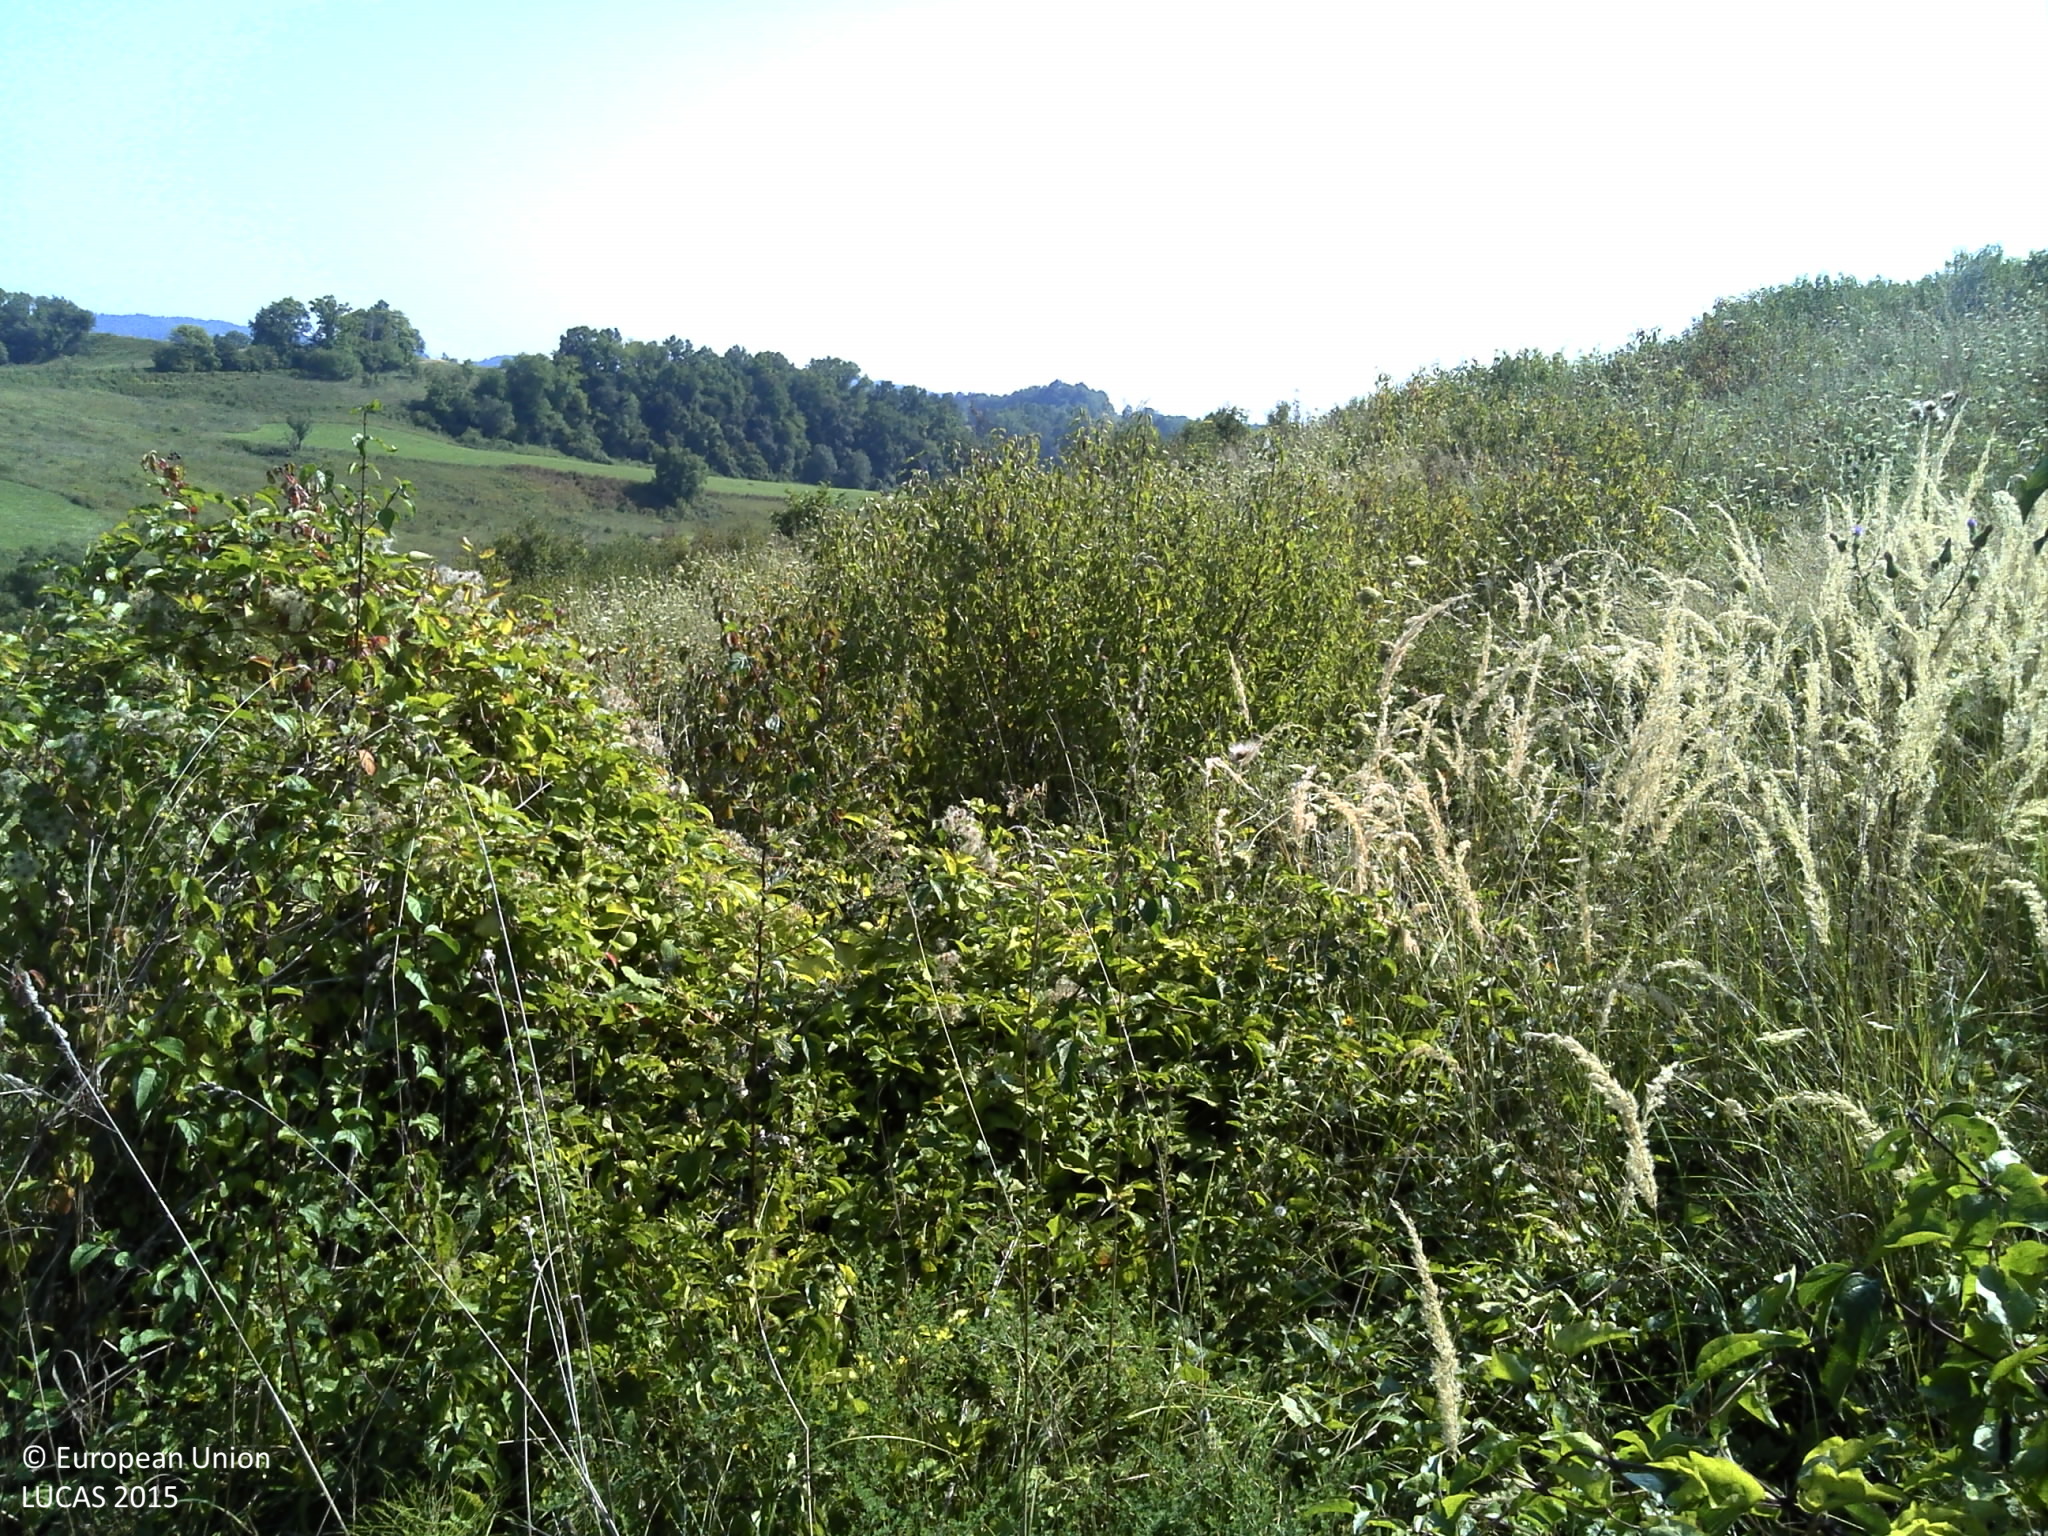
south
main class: Grassland
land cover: Spontaneously vegetated surfaces
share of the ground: > 75 %
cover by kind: herbaceous plants 100 %
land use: Semi-natural and natural areas not in use
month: August
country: HR
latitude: 45.1853
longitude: 16.3731
